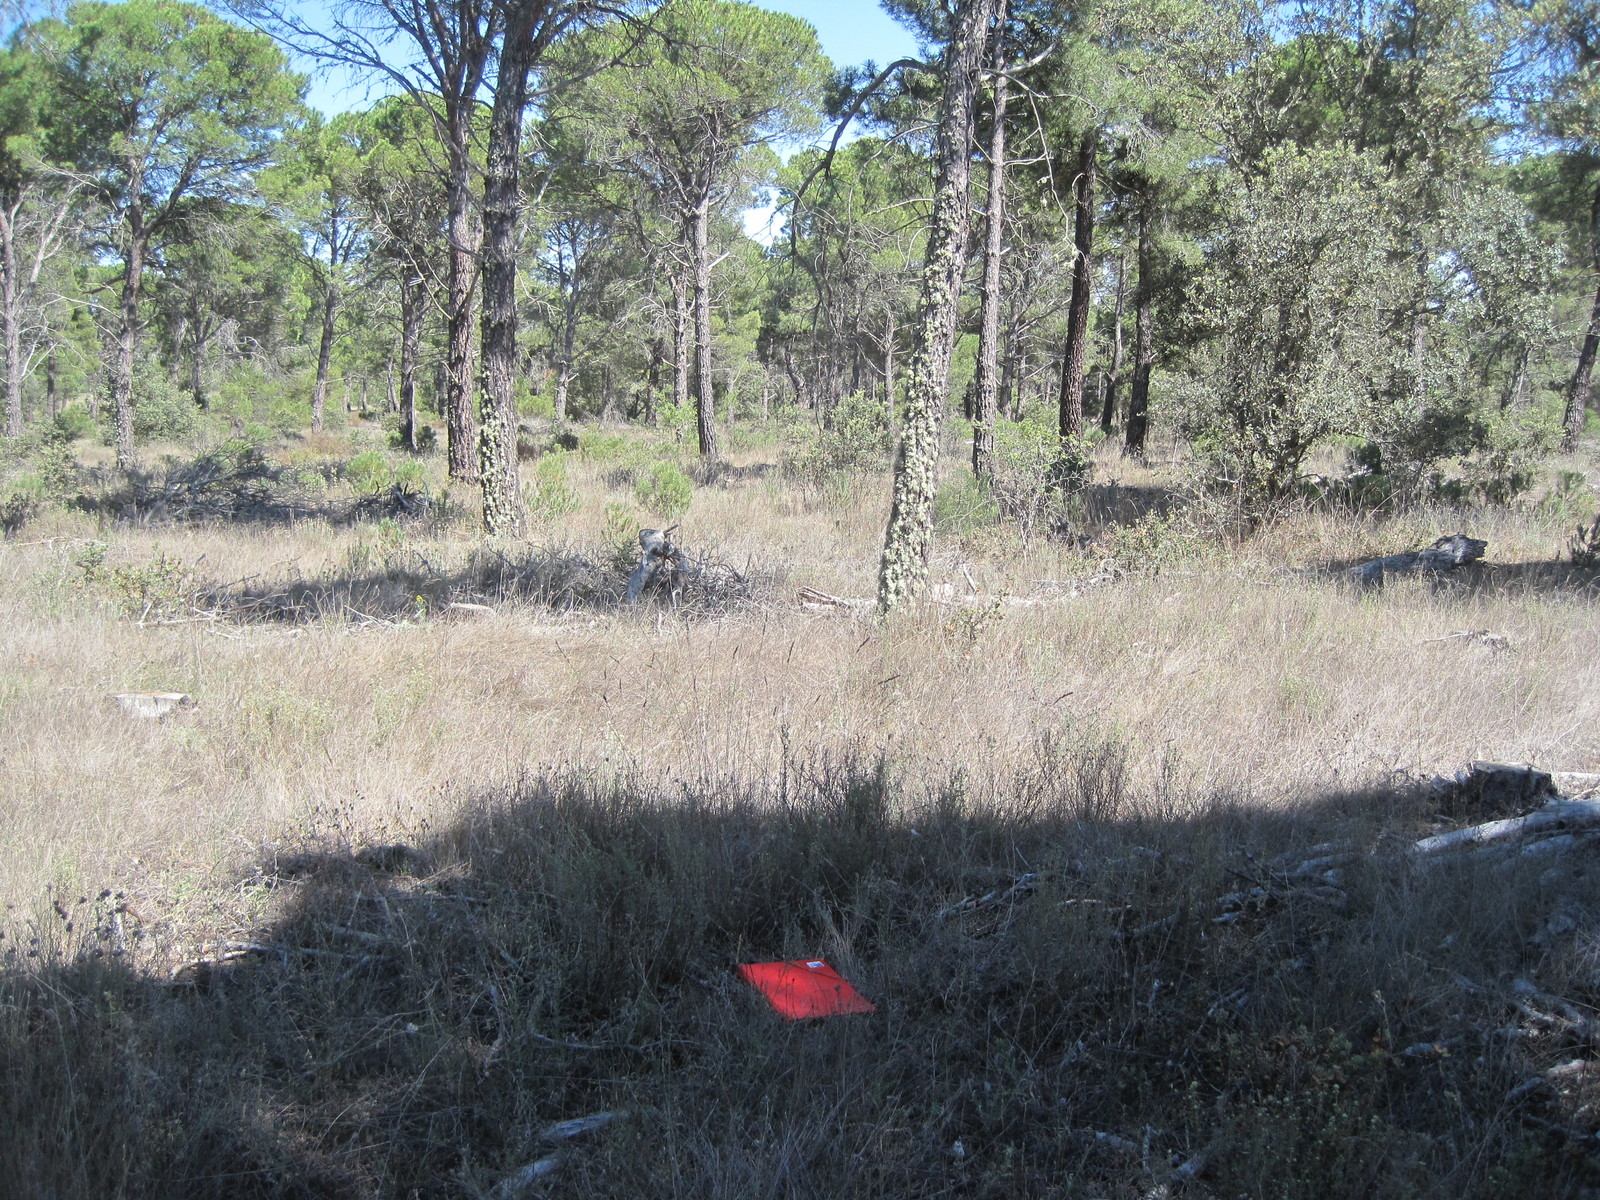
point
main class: Woodland
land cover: Pine dominated coniferous woodland
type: hemiboreal forest and nemoral coniferous forest and mixed broadleaved-coniferous forest
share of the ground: 50 - 75 %
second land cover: Grassland without tree/shrub cover
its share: > 75 %
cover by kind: coniferous forest trees 65 %, herbaceous plants 25 %, shrubs 10 %
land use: Forestry
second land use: Agriculture (excluding fallow land and kitchen gardens)
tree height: > 5 m
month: June
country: ES
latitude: 41.7802
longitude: -5.3993
